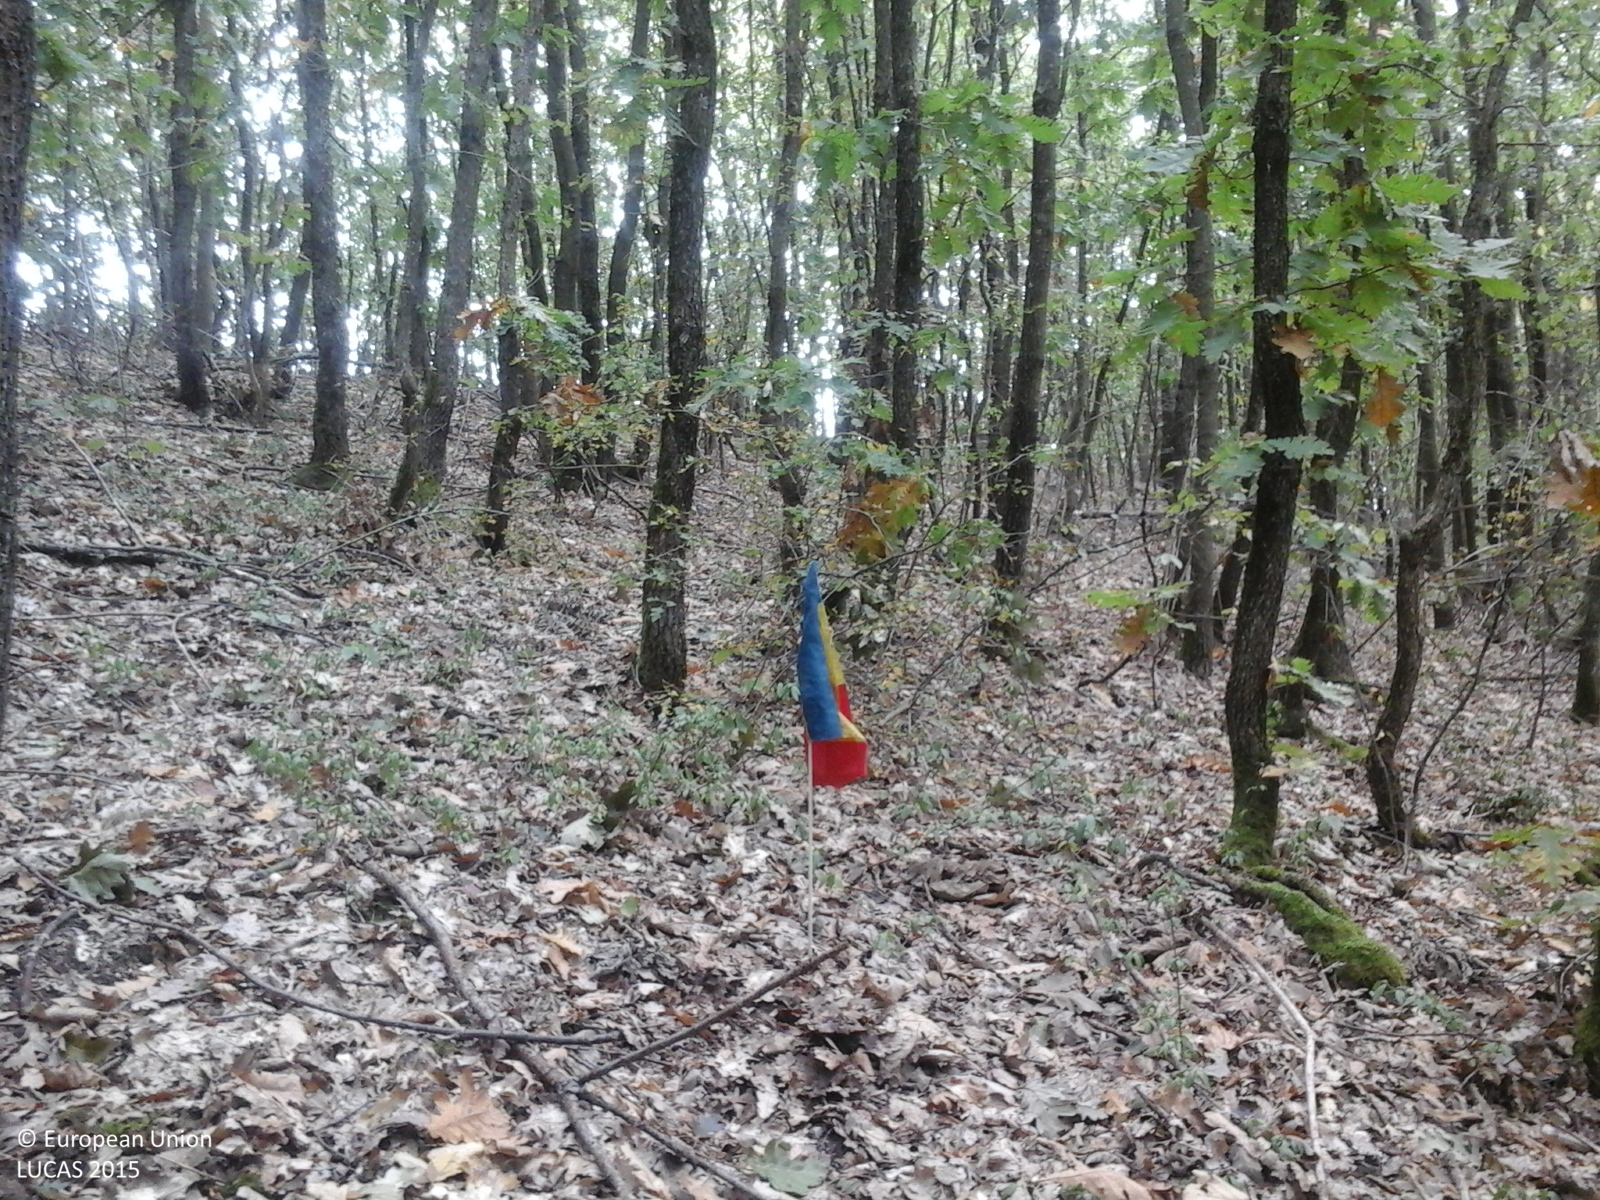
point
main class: Woodland
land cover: Broadleaved woodland
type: acidophilous oak and oak-birch forest
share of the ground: > 75 %
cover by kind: broadleaved forest trees 100 %
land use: Forestry
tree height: > 5 m
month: September
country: RO
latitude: 45.6946
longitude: 21.9695
